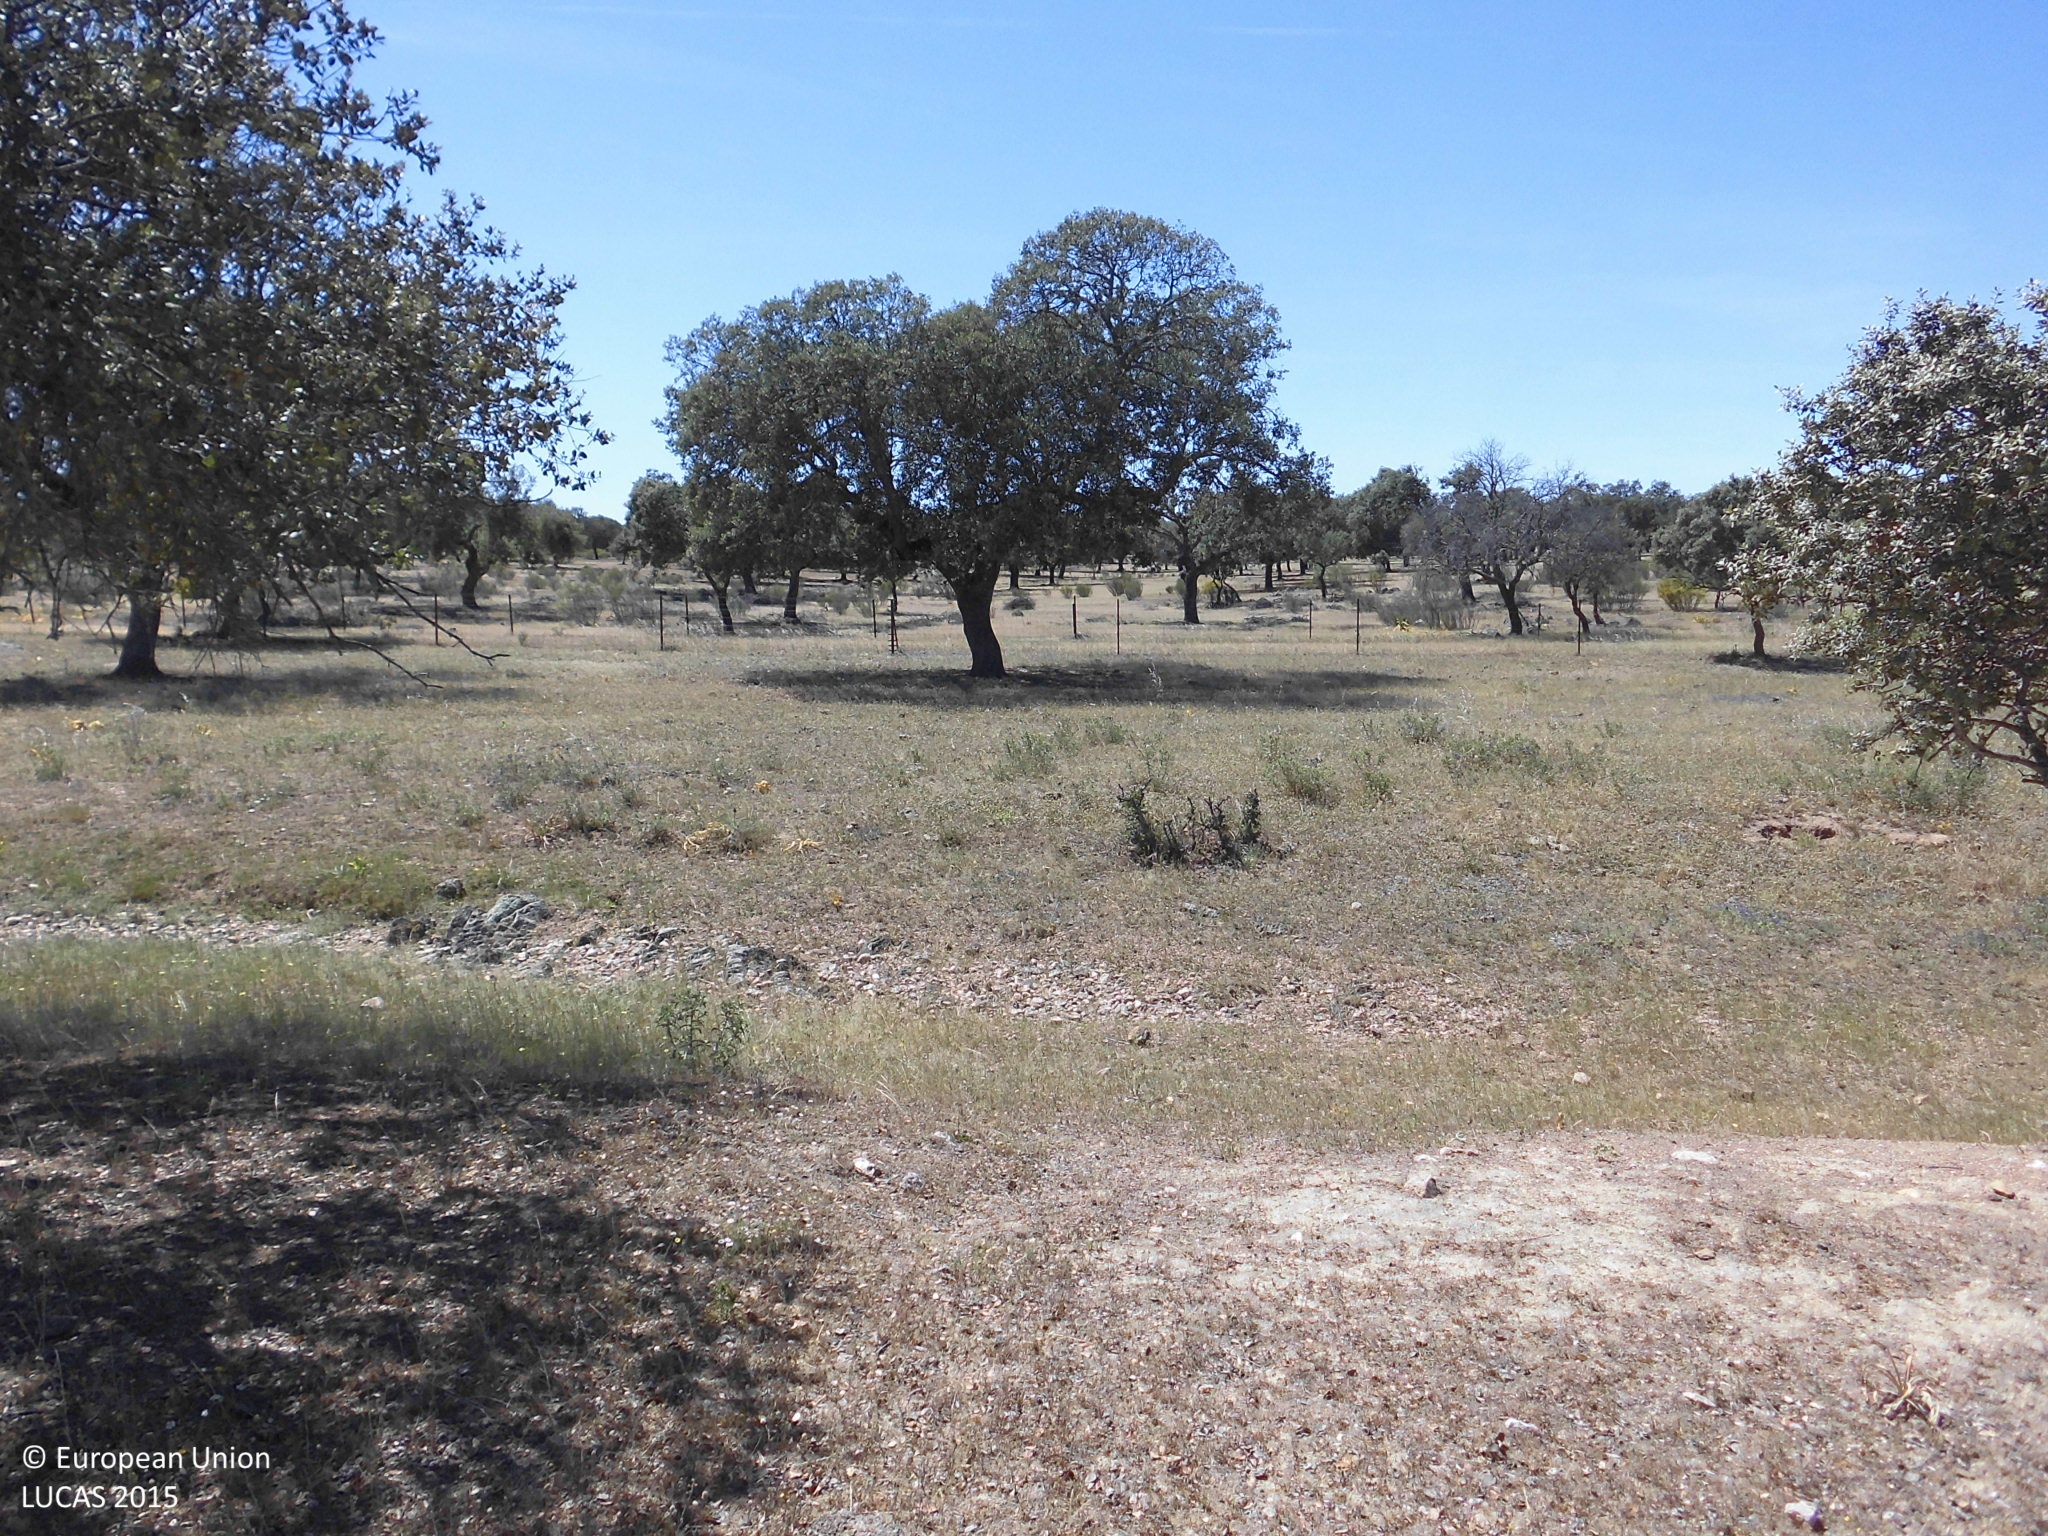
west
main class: Woodland
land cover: Broadleaved woodland
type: broadleaved evergreen forest
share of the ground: 10 - 25 %
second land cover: Grassland without tree/shrub cover
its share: > 75 %
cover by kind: herbaceous plants 80 %, broadleaved forest trees 20 %
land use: Forestry
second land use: Agriculture (excluding fallow land and kitchen gardens)
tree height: > 5 m
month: May
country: ES
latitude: 39.4500
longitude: -6.9173
